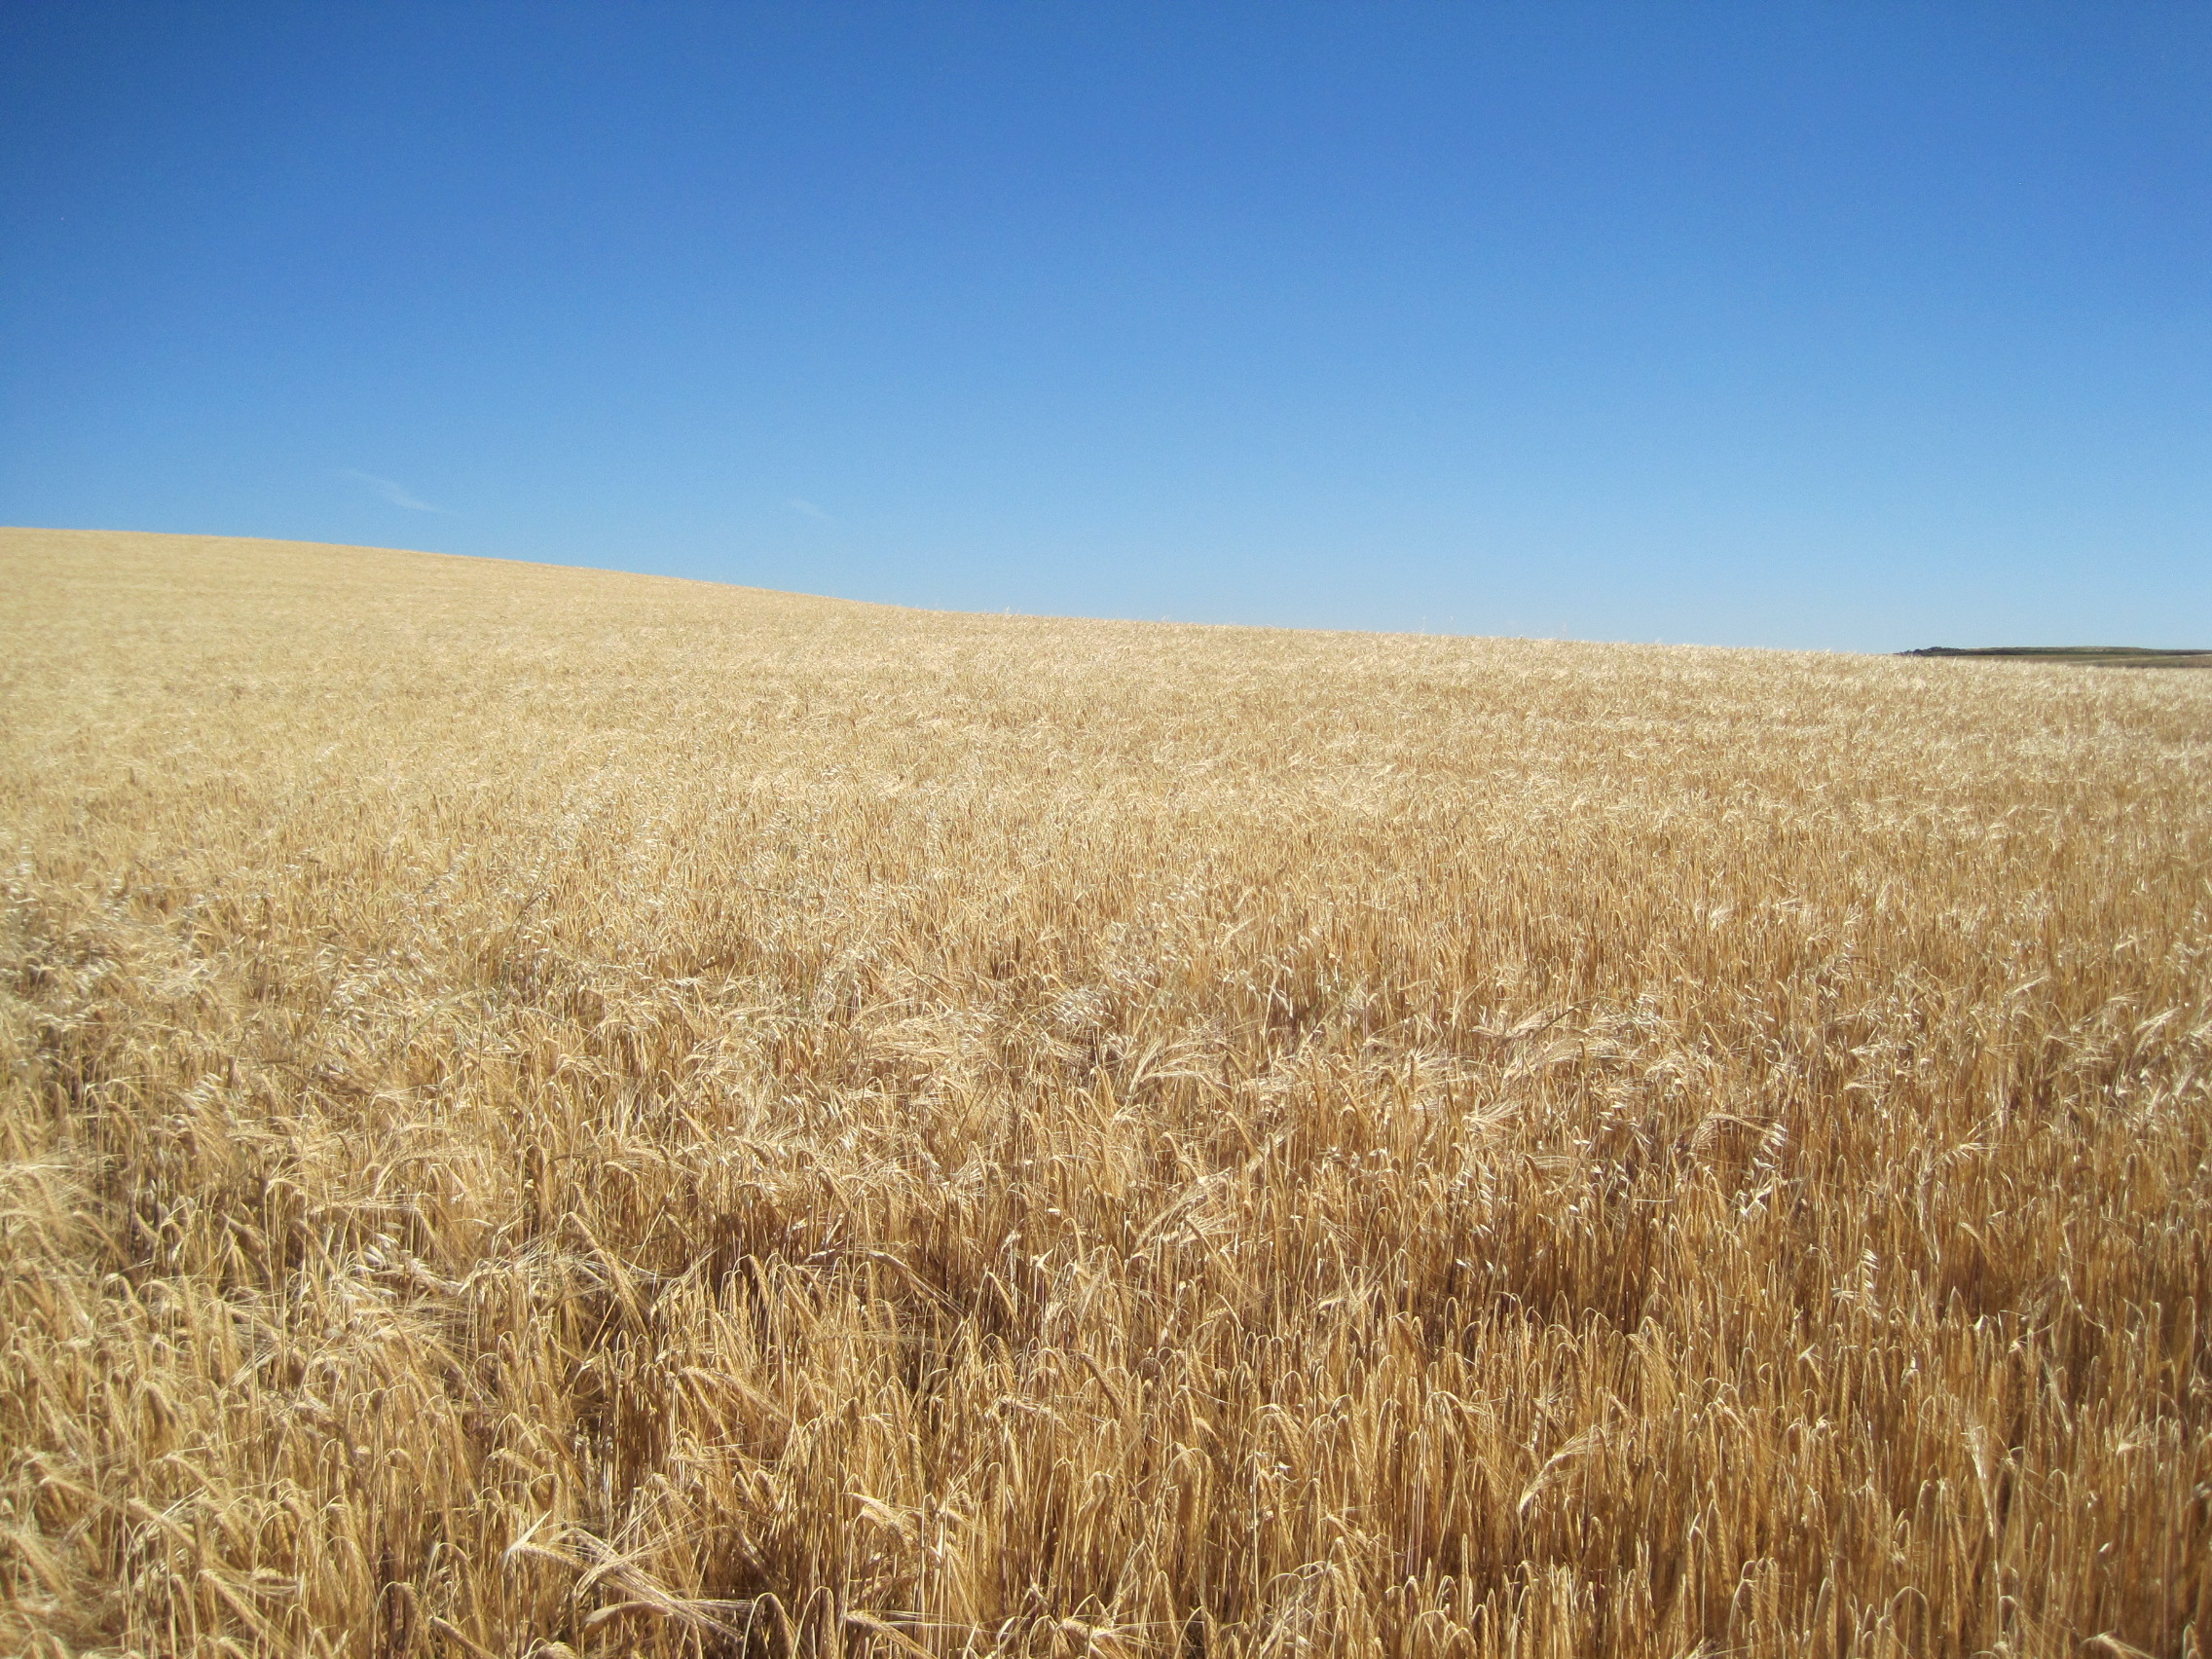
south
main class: Cropland
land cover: Barley
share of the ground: > 75 %
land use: Agriculture (excluding fallow land and kitchen gardens)
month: June
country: ES
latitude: 41.6400
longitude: -5.1188
